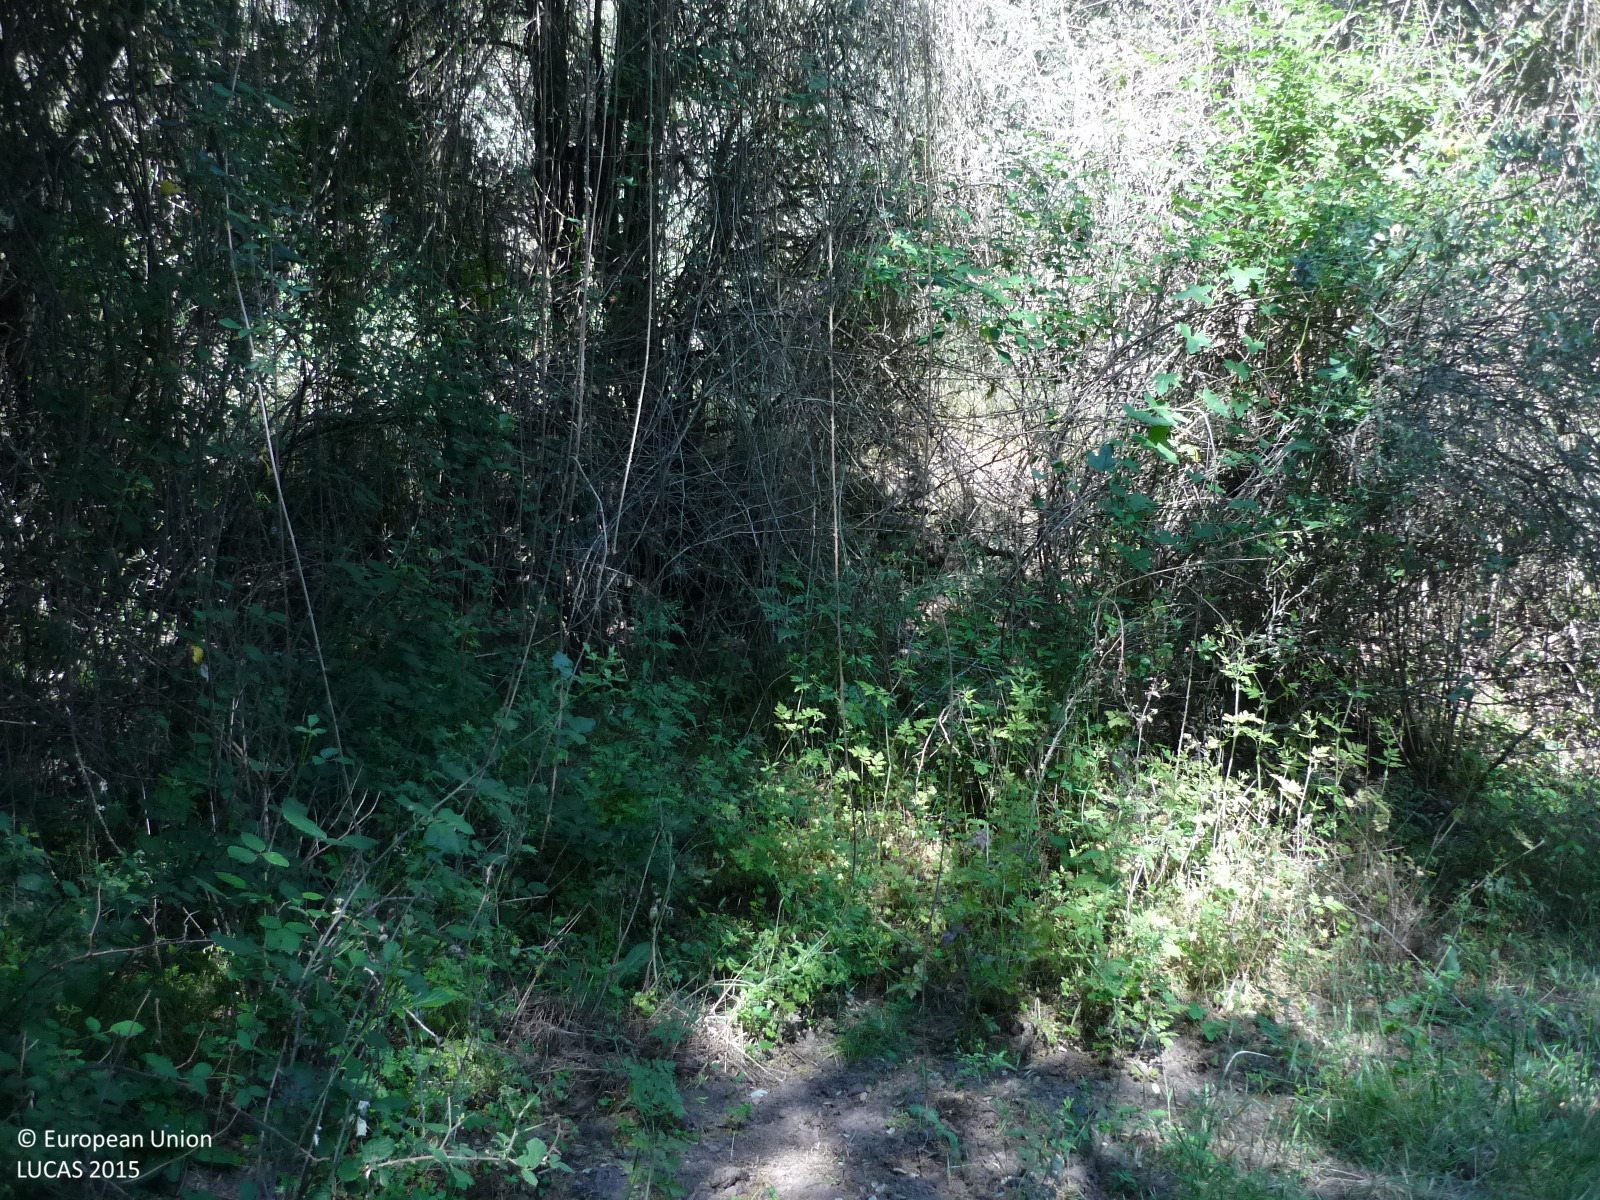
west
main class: Woodland
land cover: Broadleaved woodland
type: mesophytic deciduous forest
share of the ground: > 75 %
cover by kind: broadleaved forest trees 80 %, shrubs 10 %, herbaceous plants 10 %
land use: Semi-natural and natural areas not in use
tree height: < 5 m
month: June
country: ES
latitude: 40.7229
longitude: -3.6197
